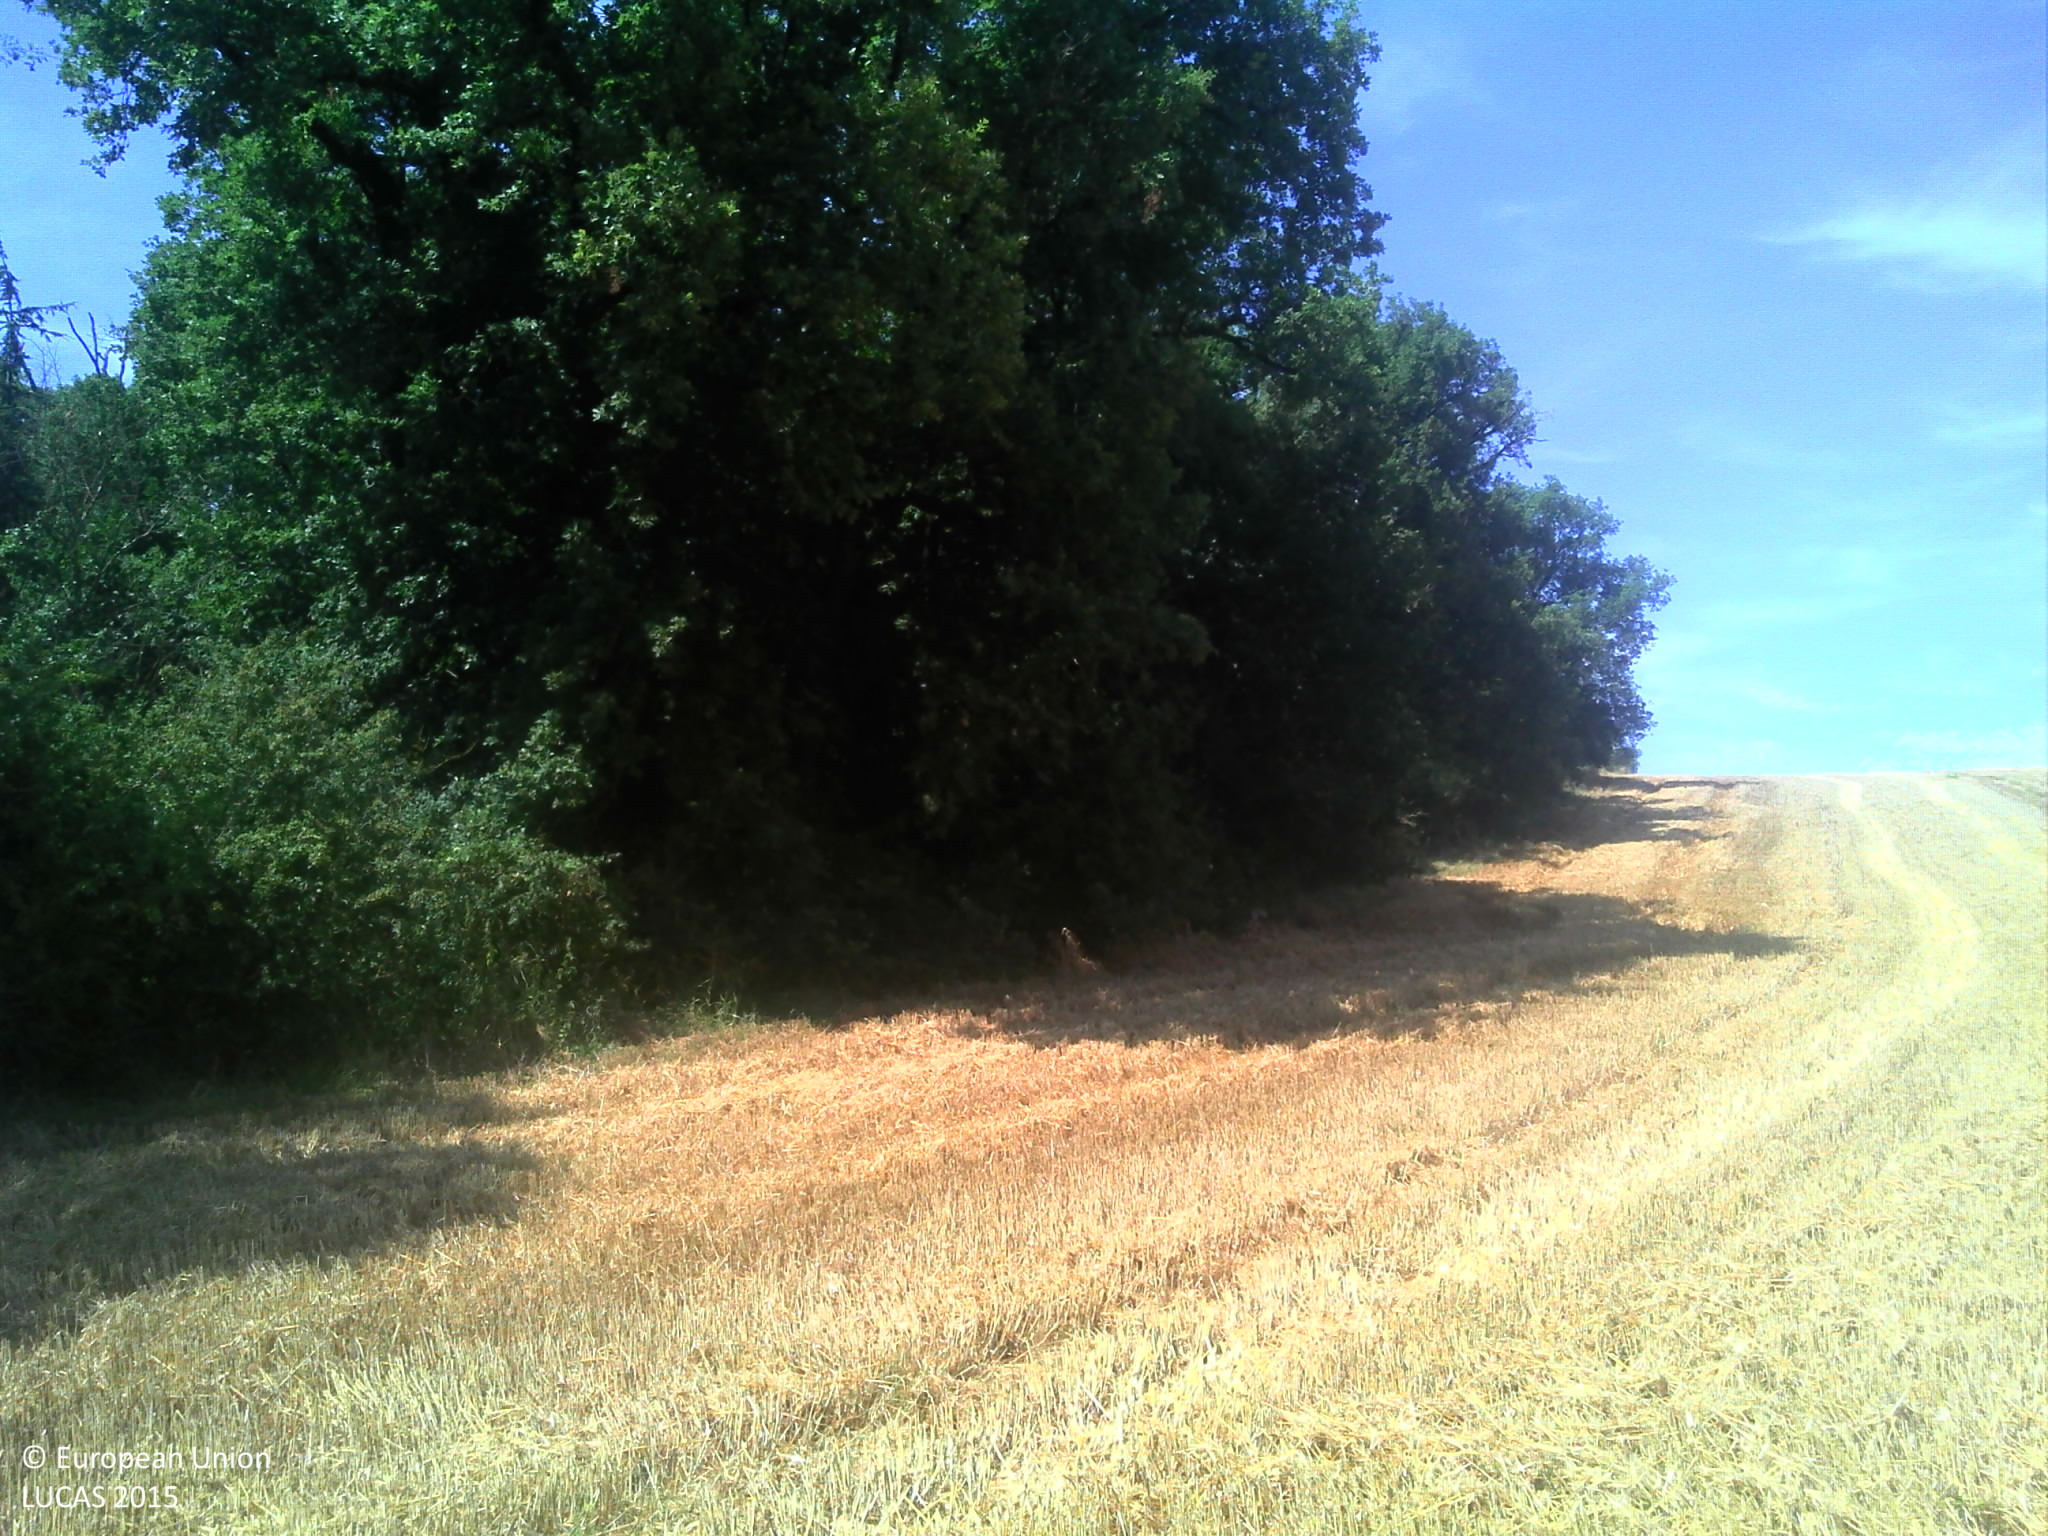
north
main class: Cropland
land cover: Durum wheat
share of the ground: > 75 %
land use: Agriculture (excluding fallow land and kitchen gardens)
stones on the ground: < 10 %
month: July
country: FR
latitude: 43.5061
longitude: 1.4316
